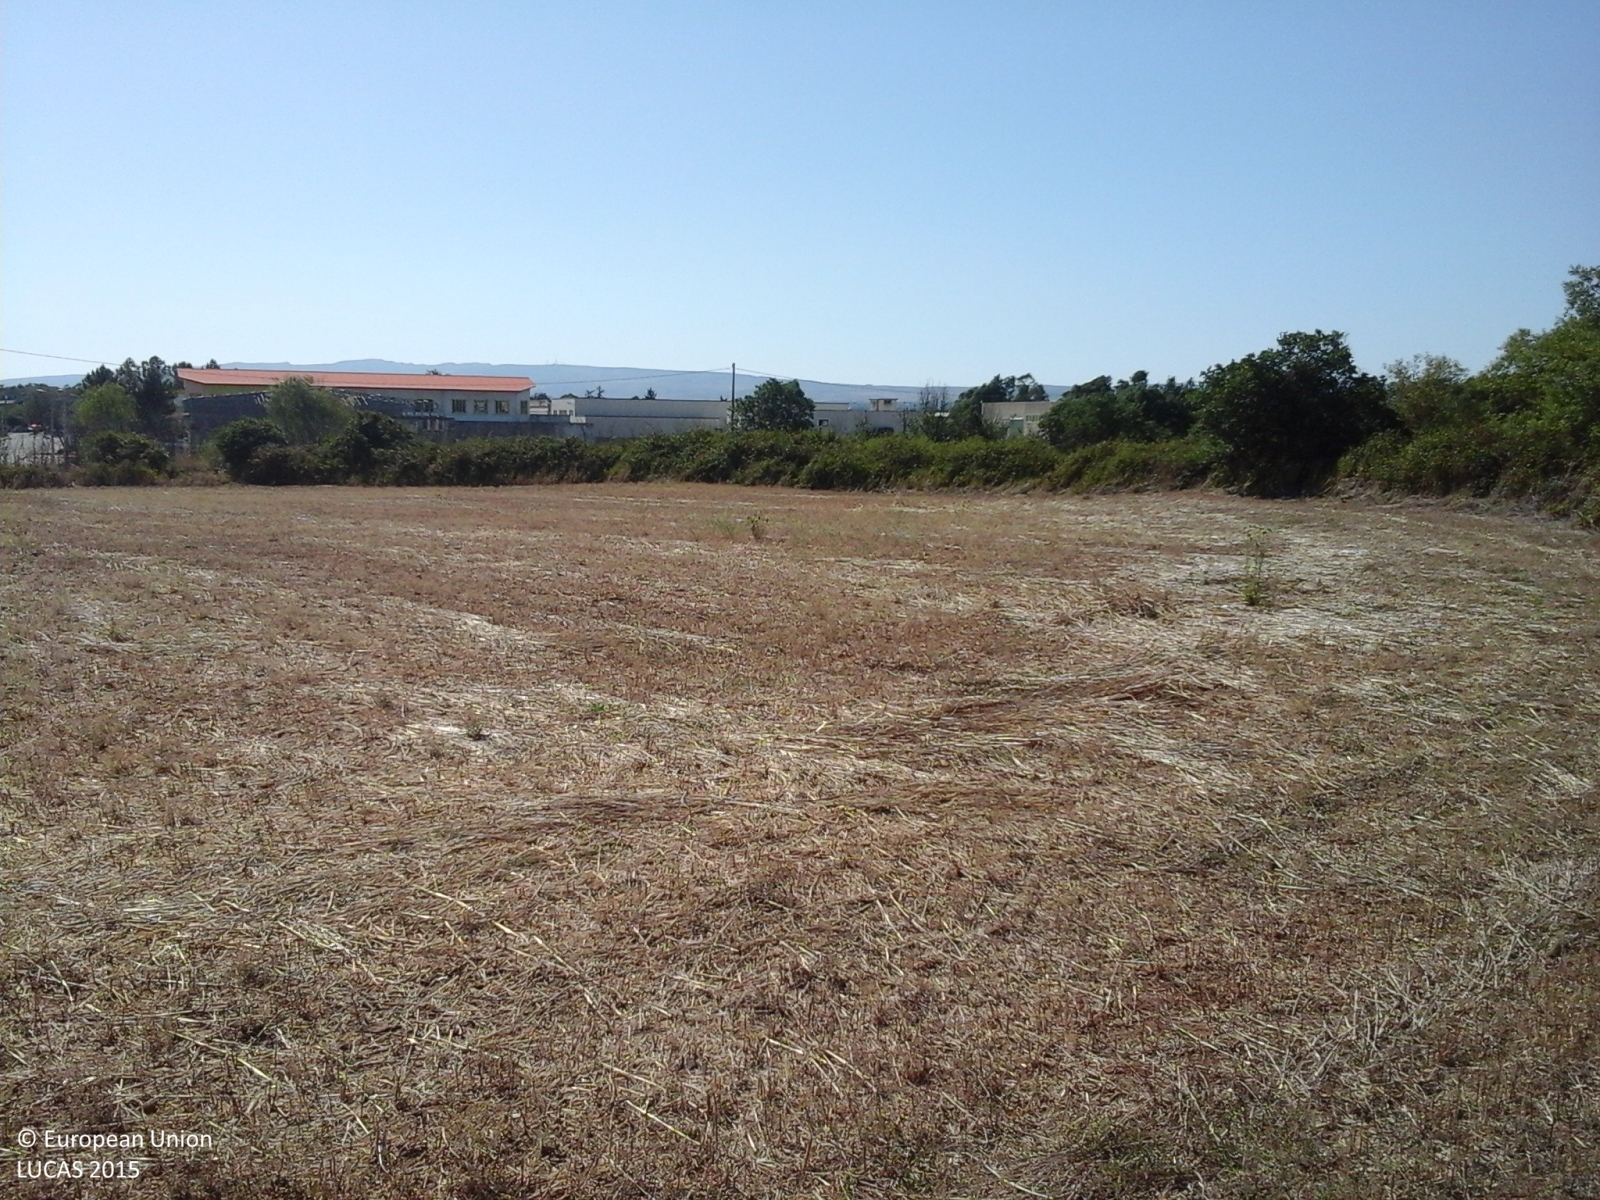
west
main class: Grassland
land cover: Grassland without tree/shrub cover
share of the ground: > 75 %
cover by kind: herbaceous plants 100 %
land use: Agriculture (excluding fallow land and kitchen gardens)
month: August
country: IT
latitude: 40.1335
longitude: 8.8210
